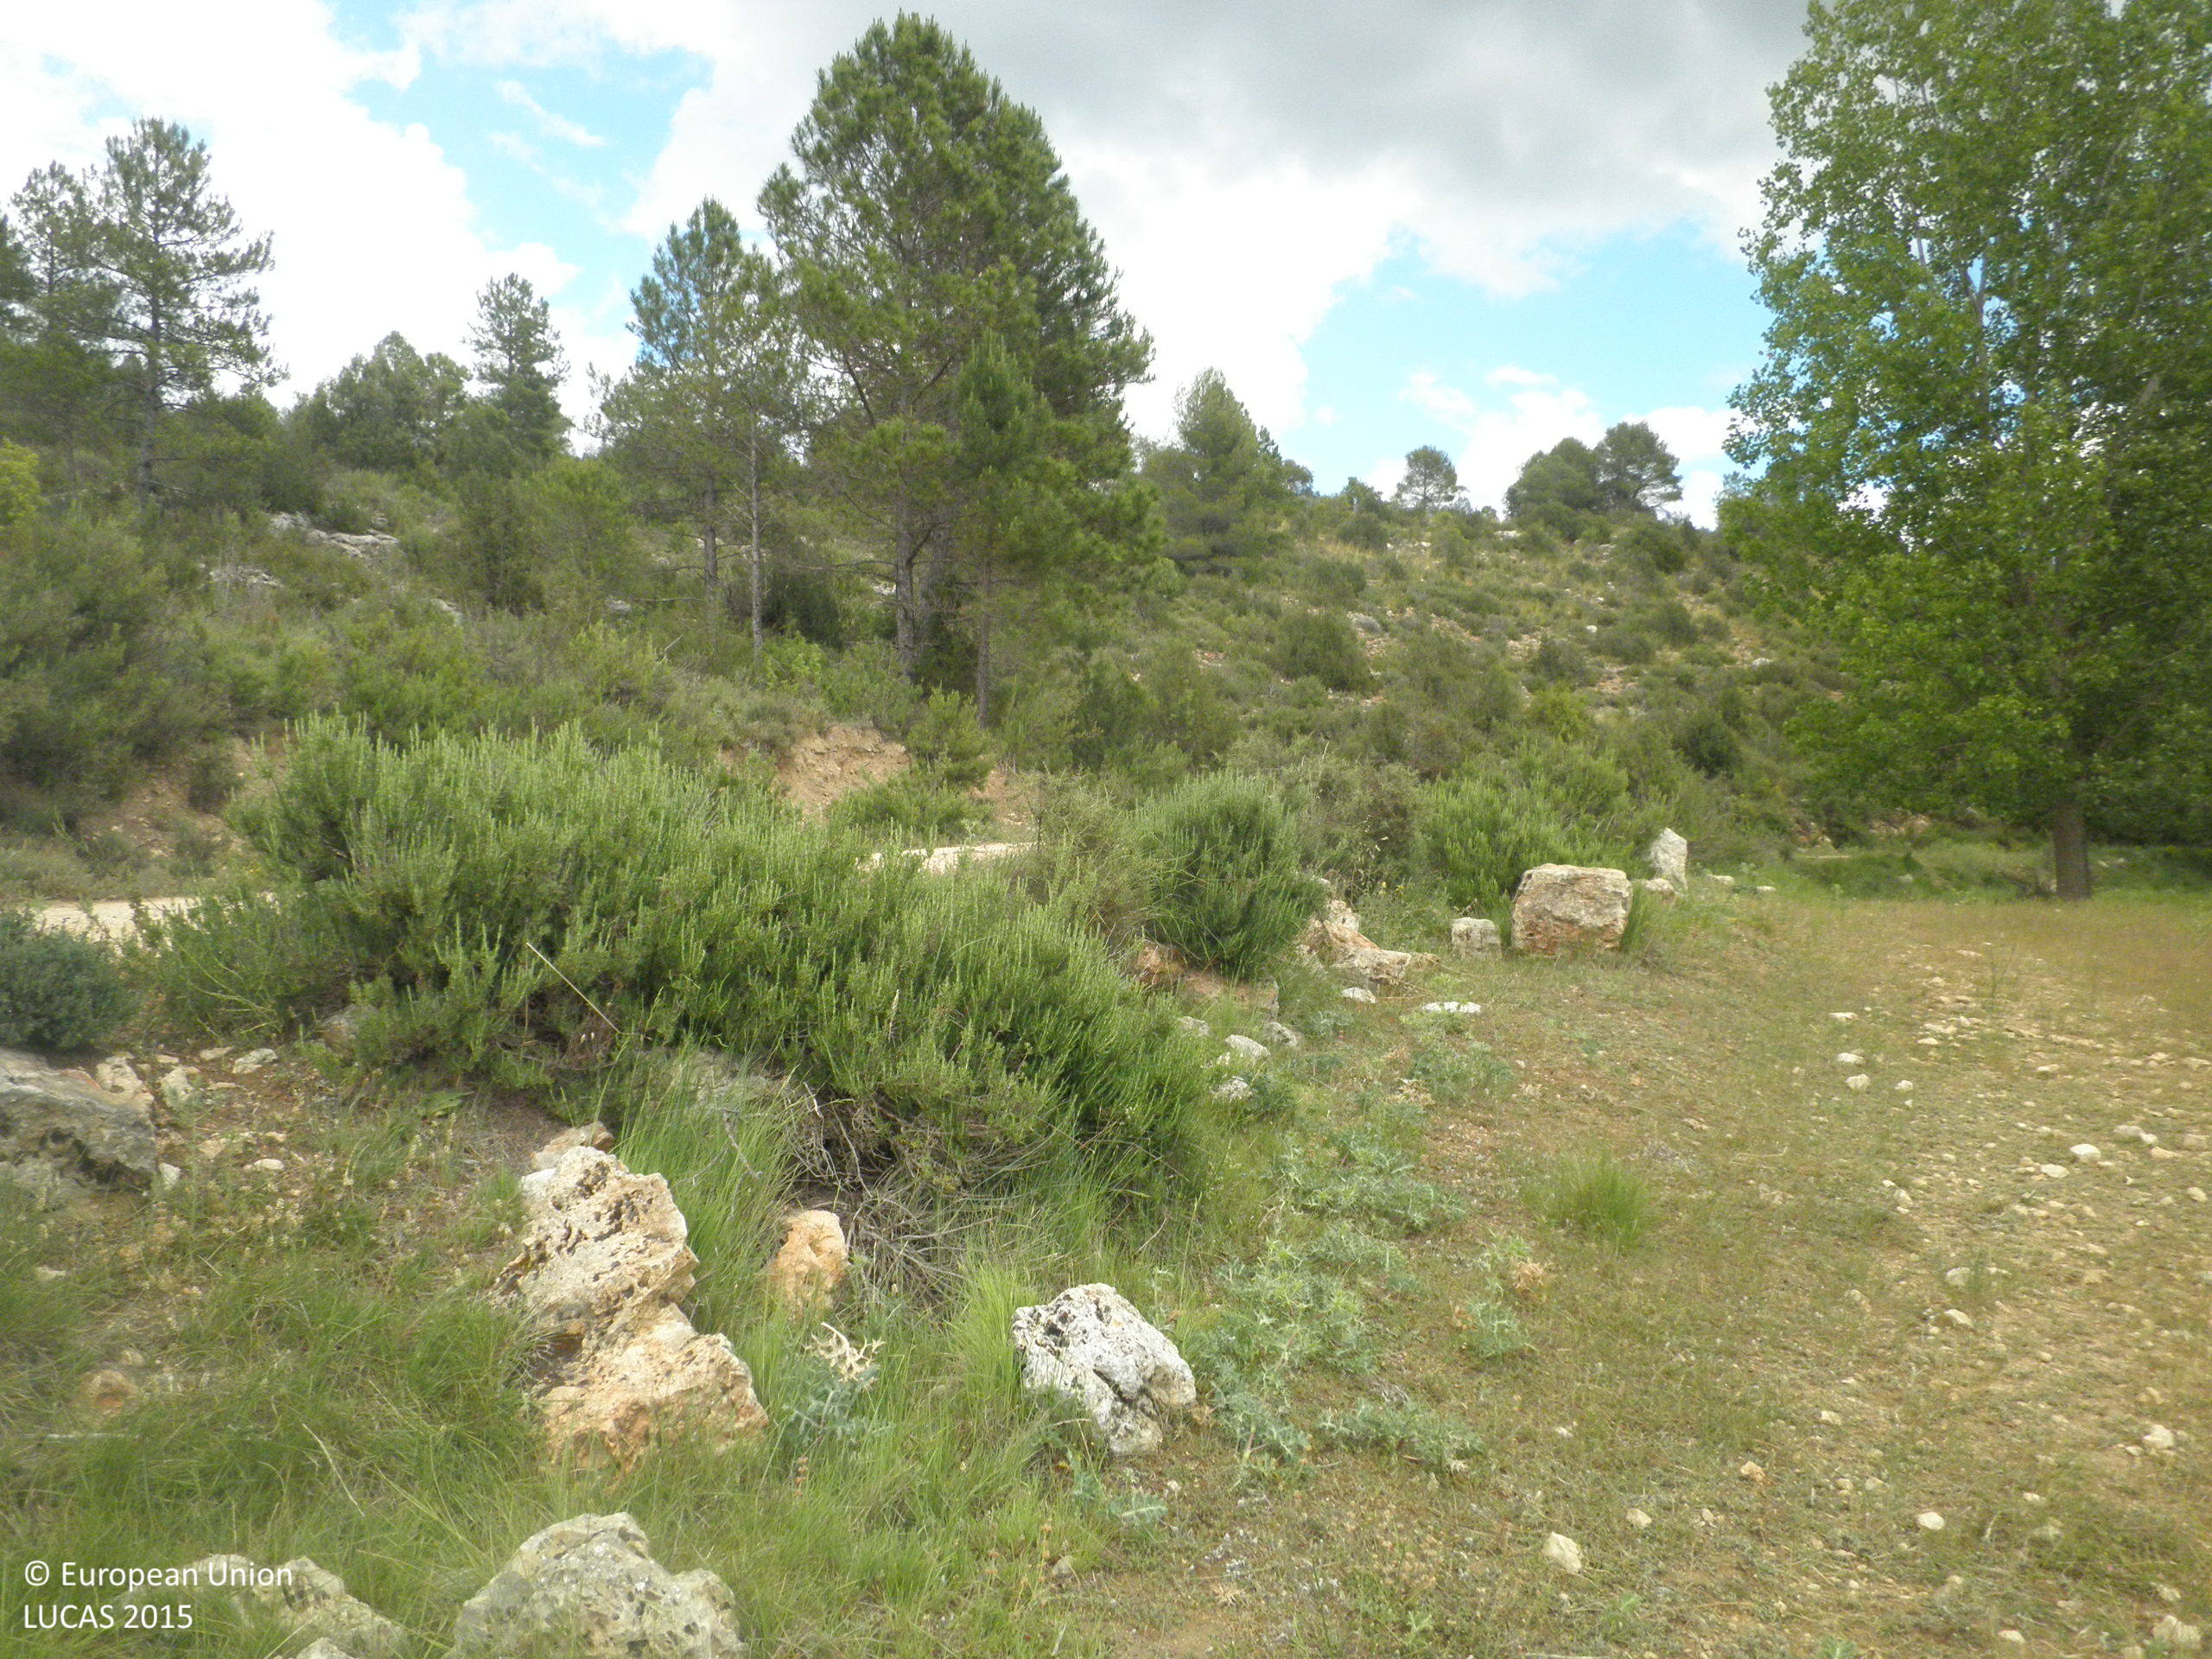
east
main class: Grassland
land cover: Spontaneously vegetated surfaces
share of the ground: > 75 %
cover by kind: herbaceous plants 90 %, unconsolidated bare surface 10 %
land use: Abandoned areas
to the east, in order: Spontaneously vegetated surfaces; Grass margins; Dry stone walls; Grass margins; Tracks; Shrubland with sparse tree cover; Pine dominated coniferous woodland; Tracks; Pine dominated coniferous woodland
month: June
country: ES
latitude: 39.7966
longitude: -1.7464
